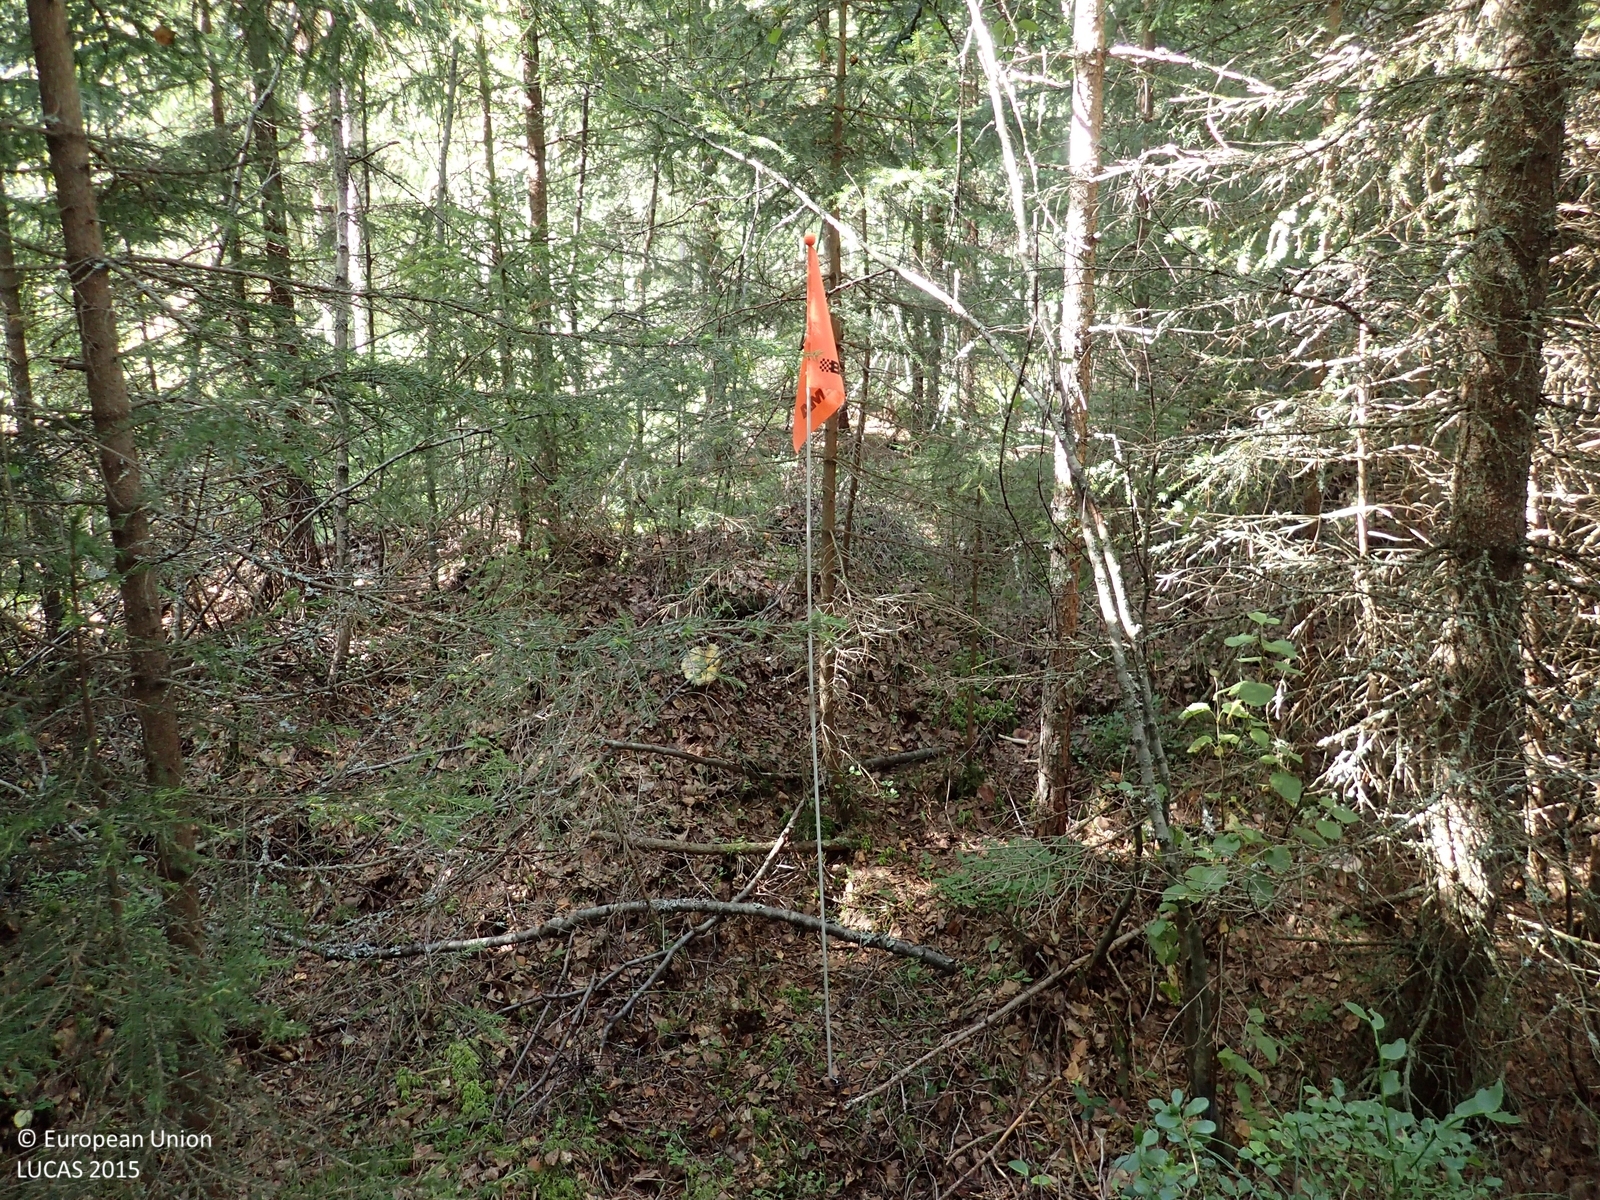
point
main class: Woodland
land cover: Other mixed woodland
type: boreal forest
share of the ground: > 75 %
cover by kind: coniferous forest trees 60 %, broadleaved forest trees 25 %, shrubs 10 %, lichens and mosses 5 %
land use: Forestry
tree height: > 5 m
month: August
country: FI
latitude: 62.2809
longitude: 23.0350
